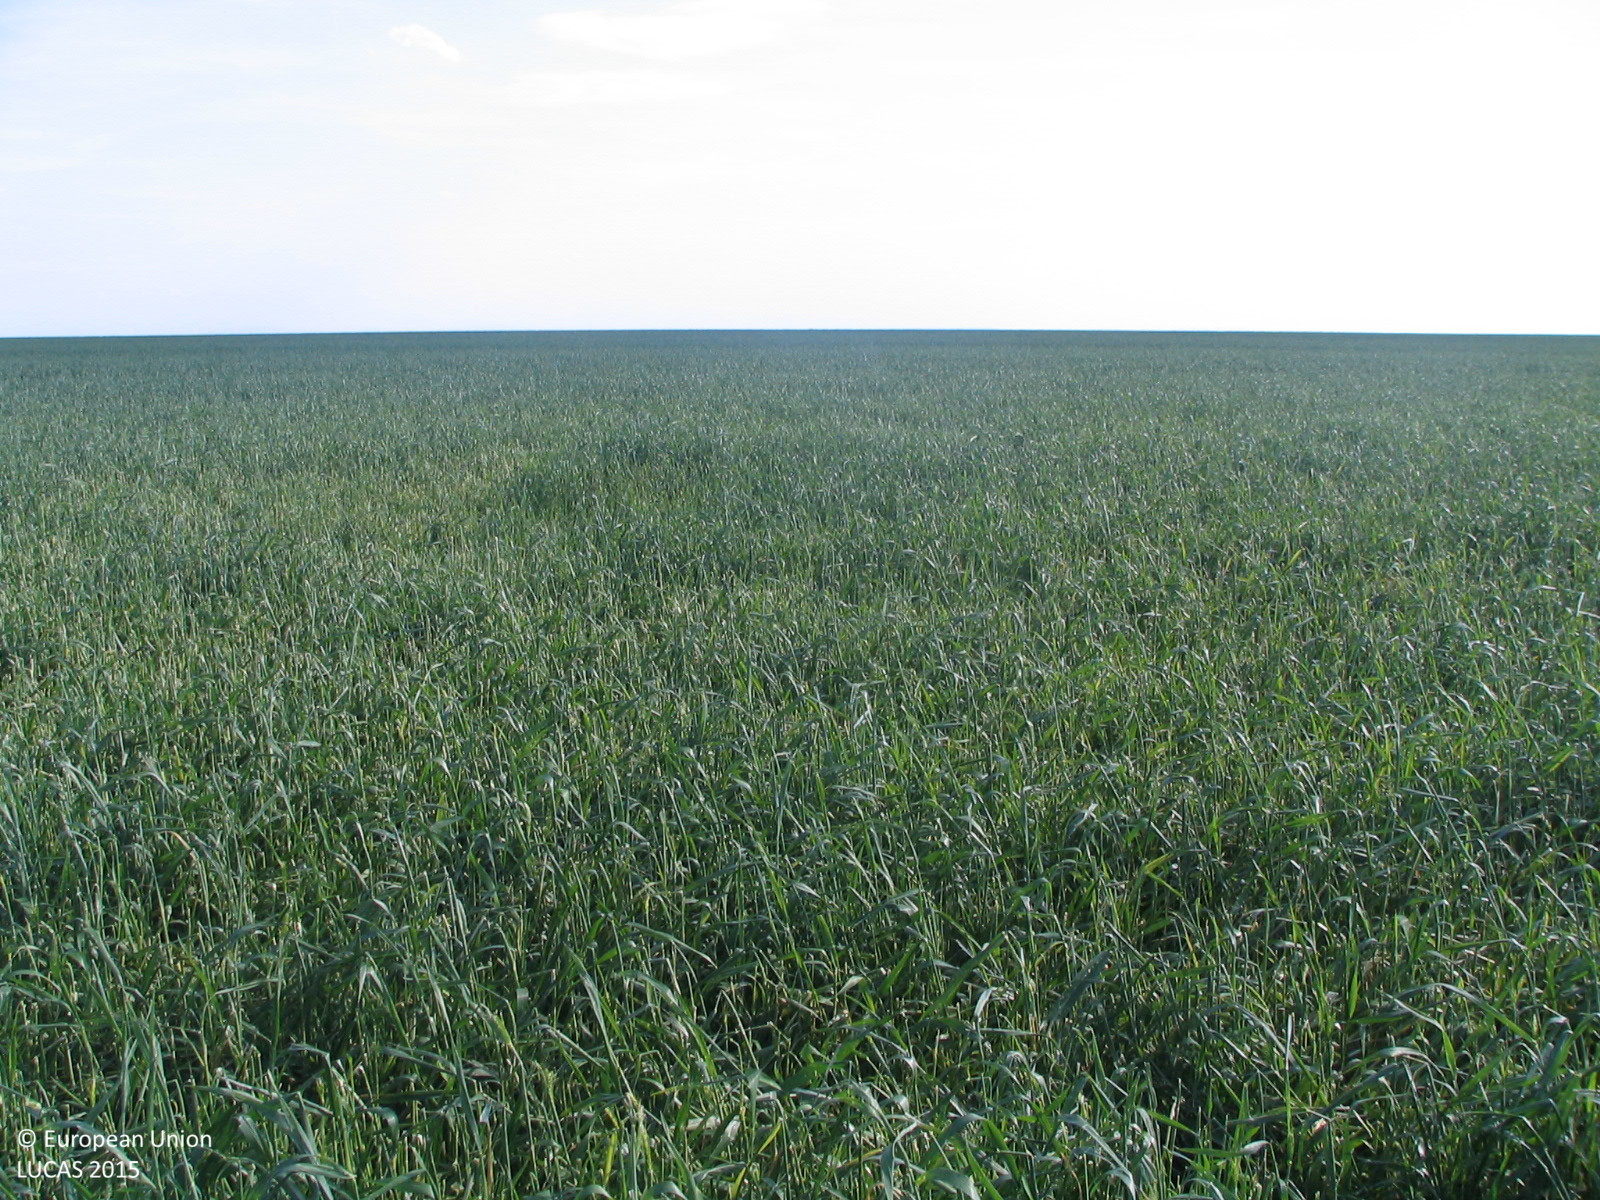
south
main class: Cropland
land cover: Common wheat
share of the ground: > 75 %
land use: Agriculture (excluding fallow land and kitchen gardens)
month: May
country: BG
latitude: 43.5632
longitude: 23.9810
